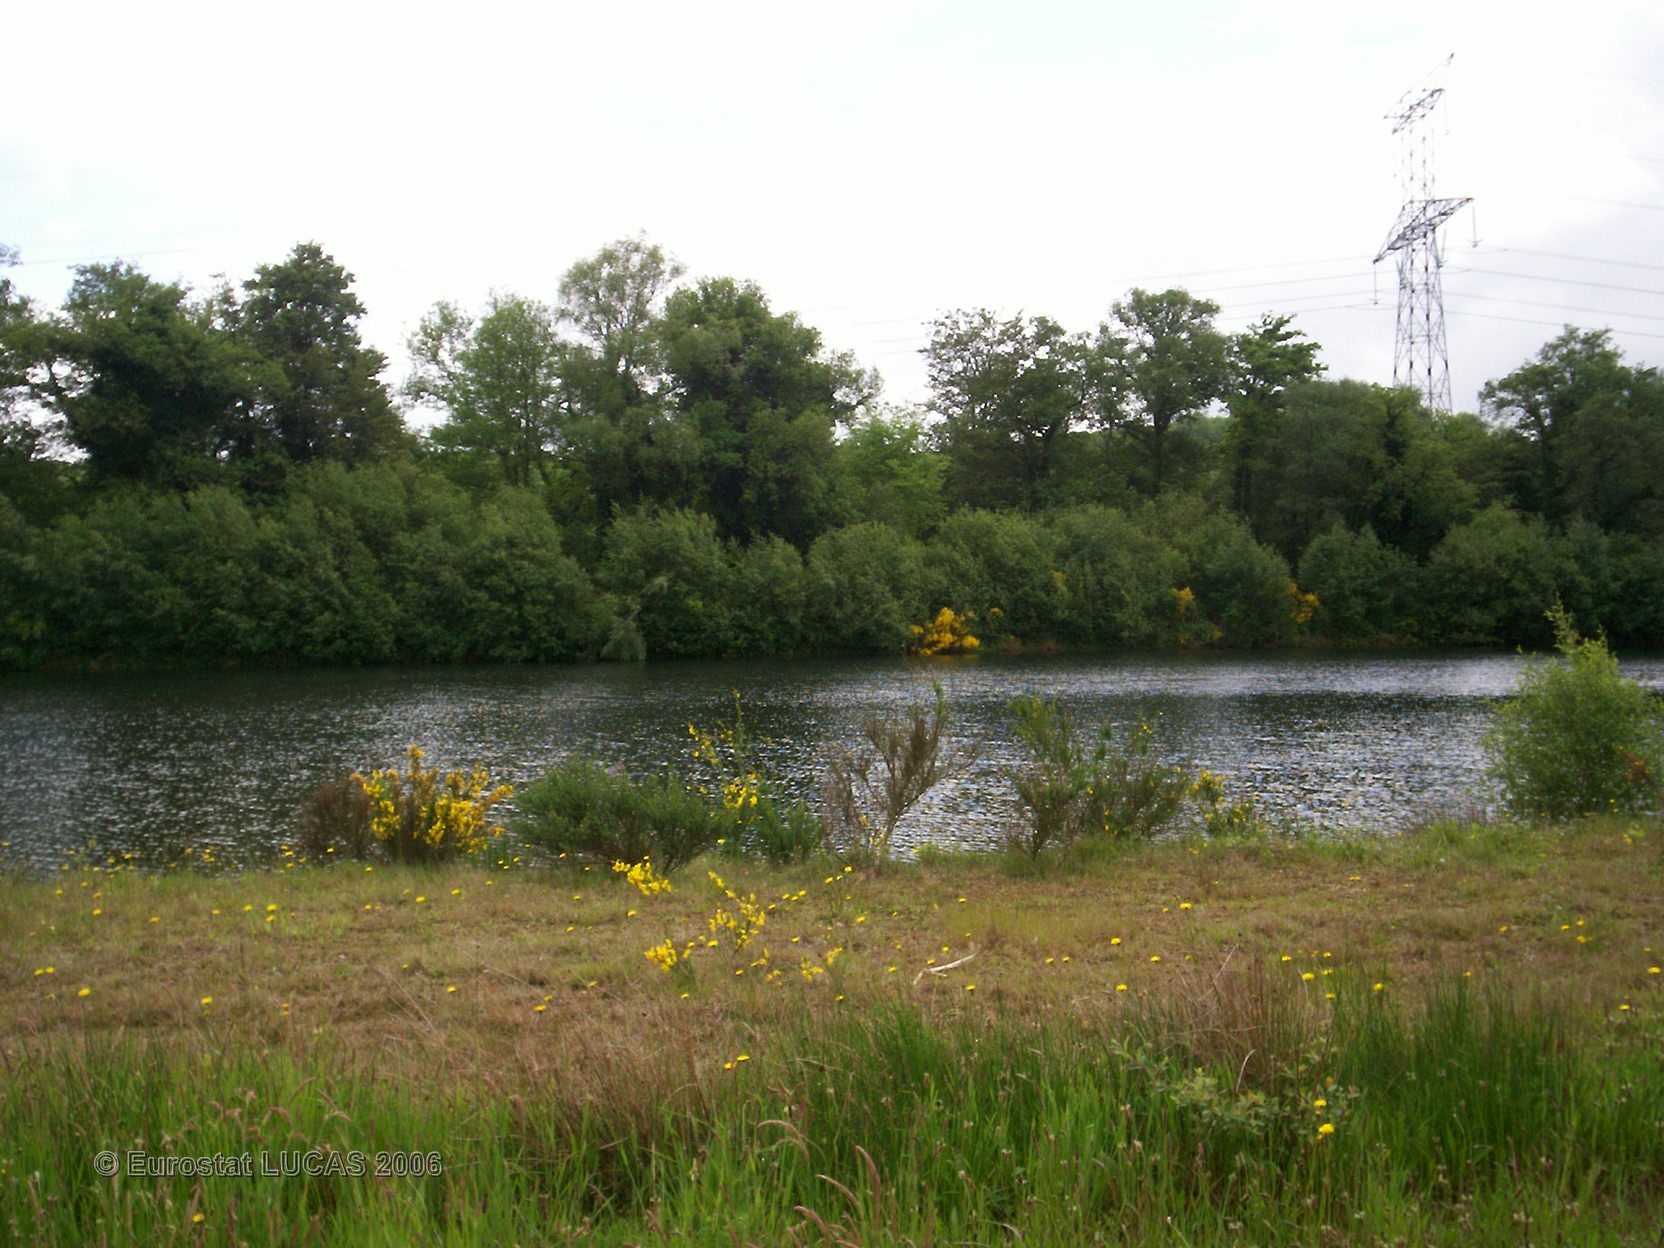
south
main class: Grassland
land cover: Grassland without tree/shrub cover
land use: Fallow land
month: May
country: FR
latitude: 47.9465
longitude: -3.5599
